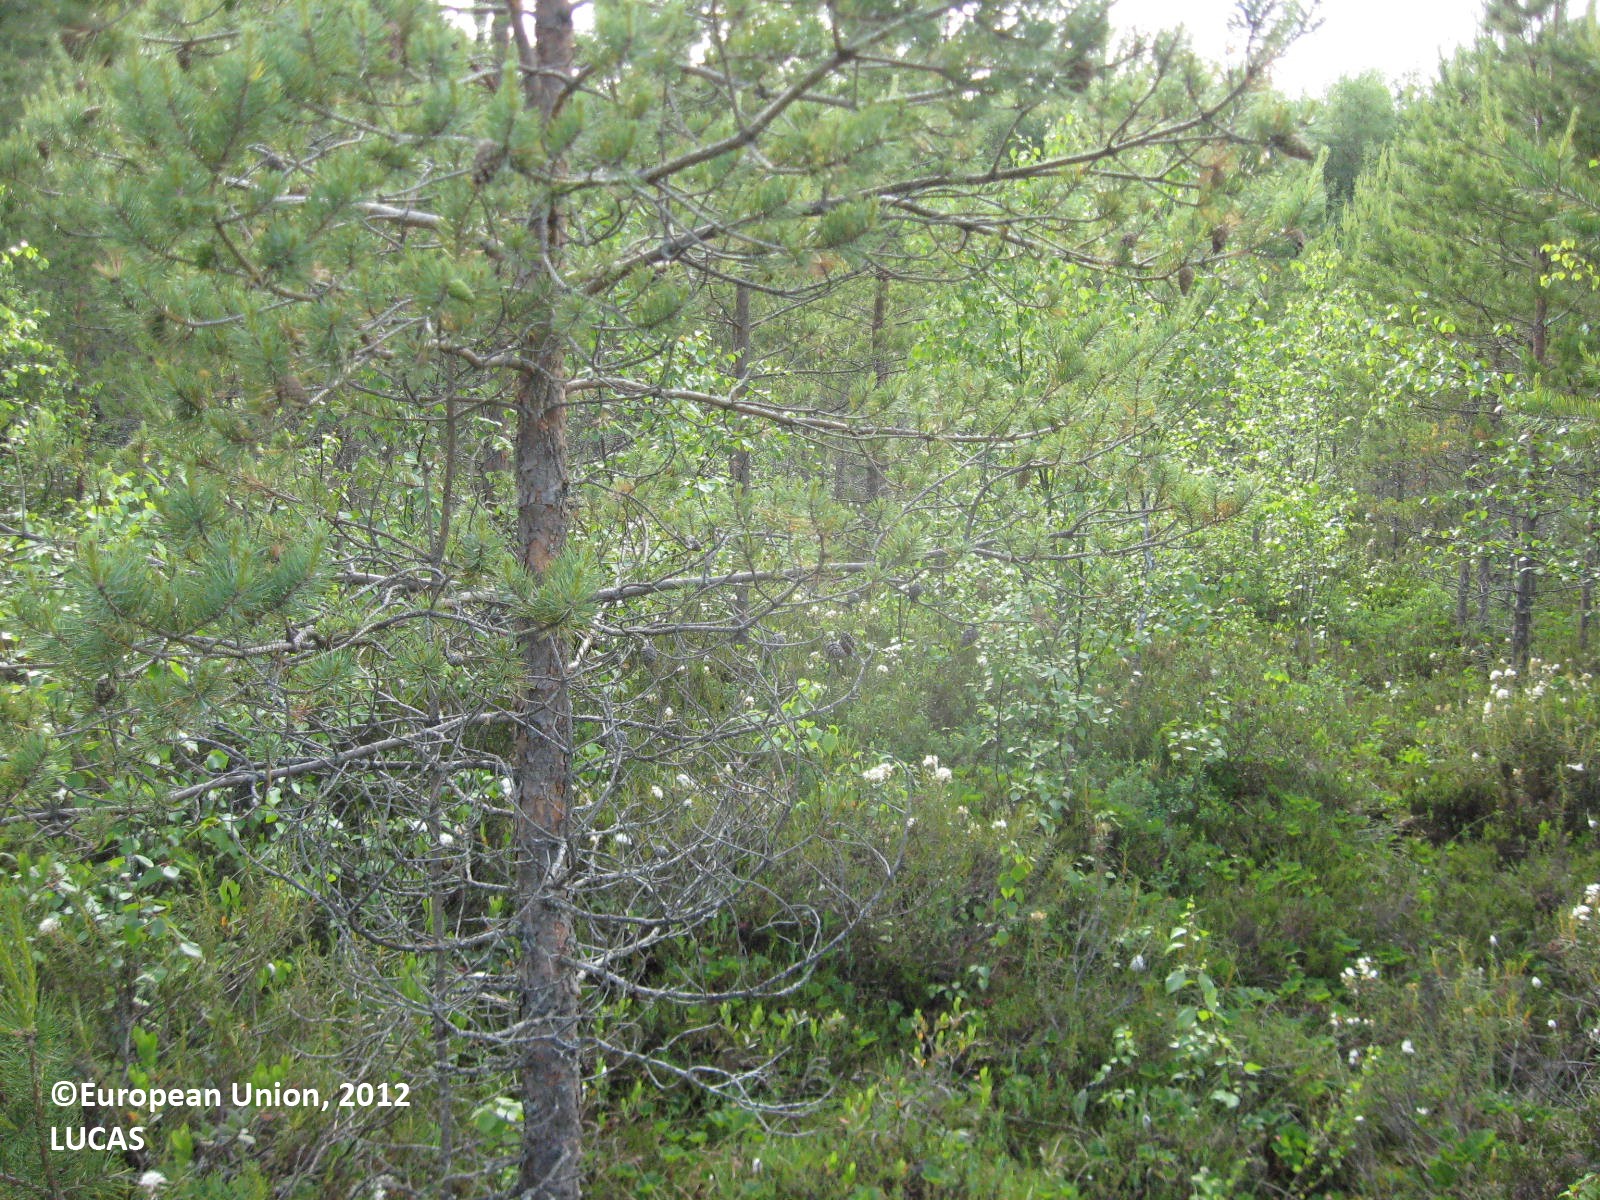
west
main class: Woodland
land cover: Pine dominated coniferous woodland
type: boreal forest
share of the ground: 50 - 75 %
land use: Forestry
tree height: > 5 m
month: June
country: FI
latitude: 63.0127
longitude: 22.8359
